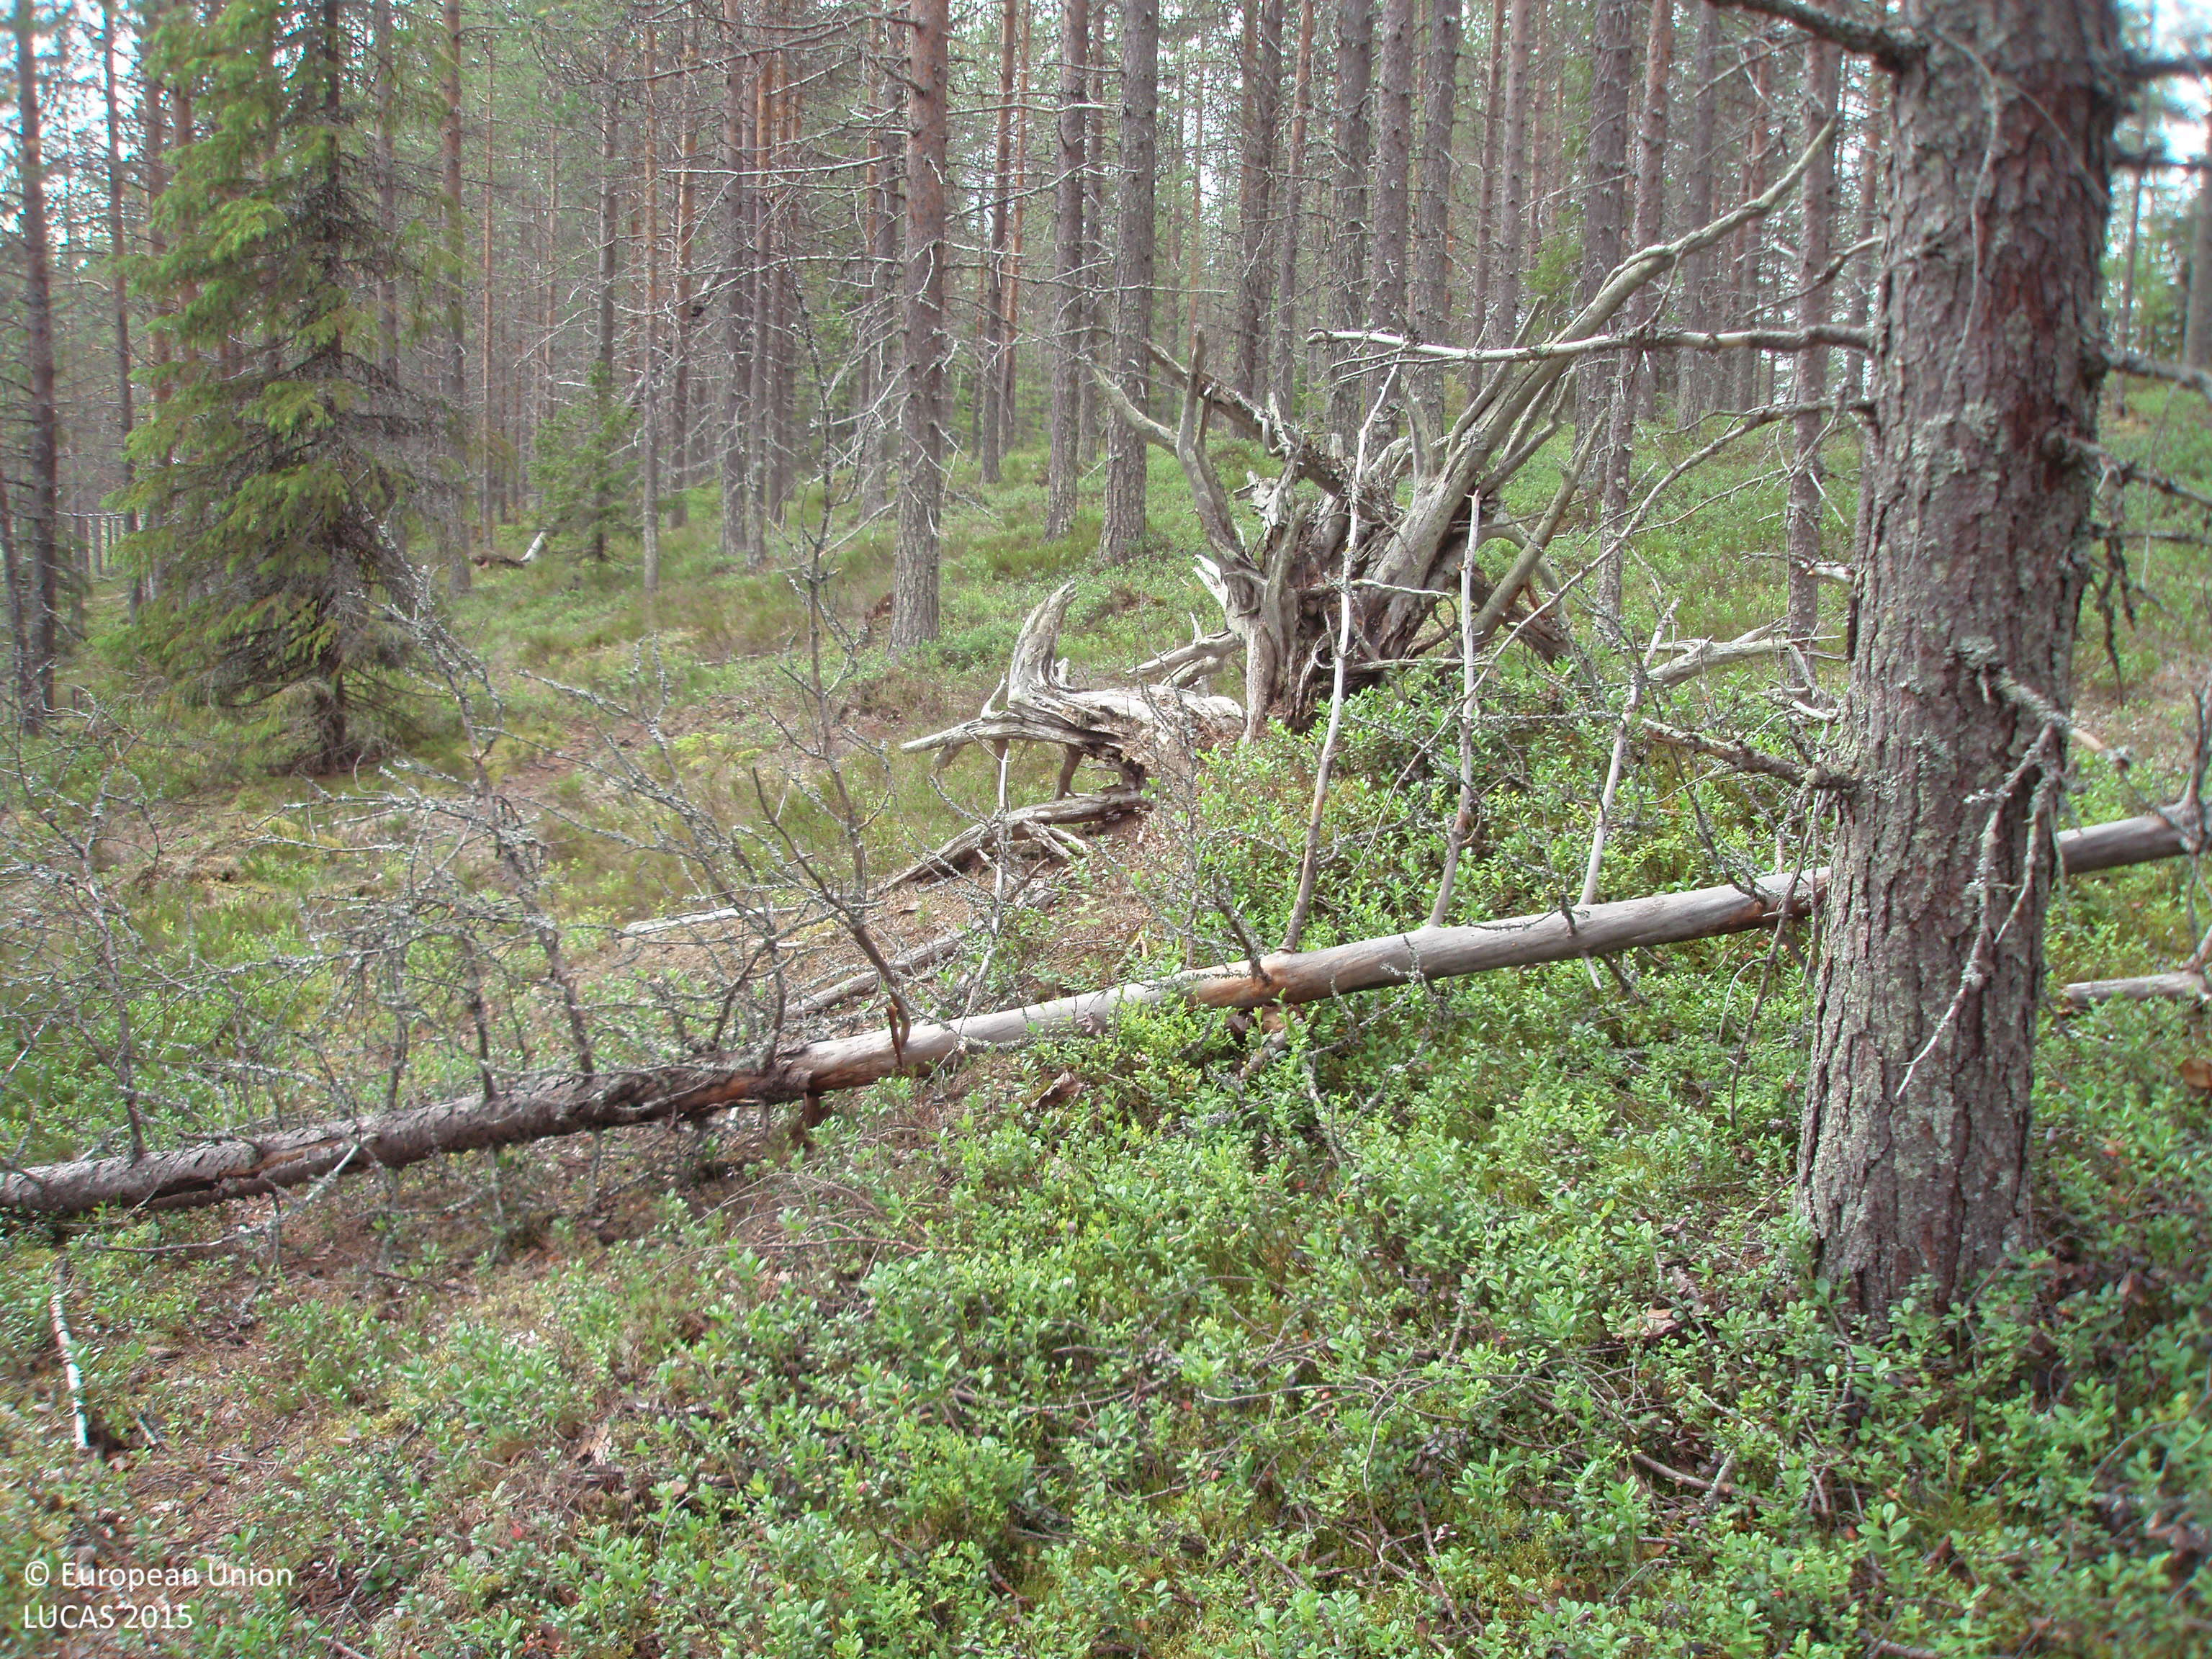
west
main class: Woodland
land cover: Pine dominated coniferous woodland
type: boreal forest
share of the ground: 50 - 75 %
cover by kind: coniferous forest trees 70 %, shrubs 30 %
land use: Forestry
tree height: > 5 m
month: July
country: FI
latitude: 65.6831
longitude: 27.6959
